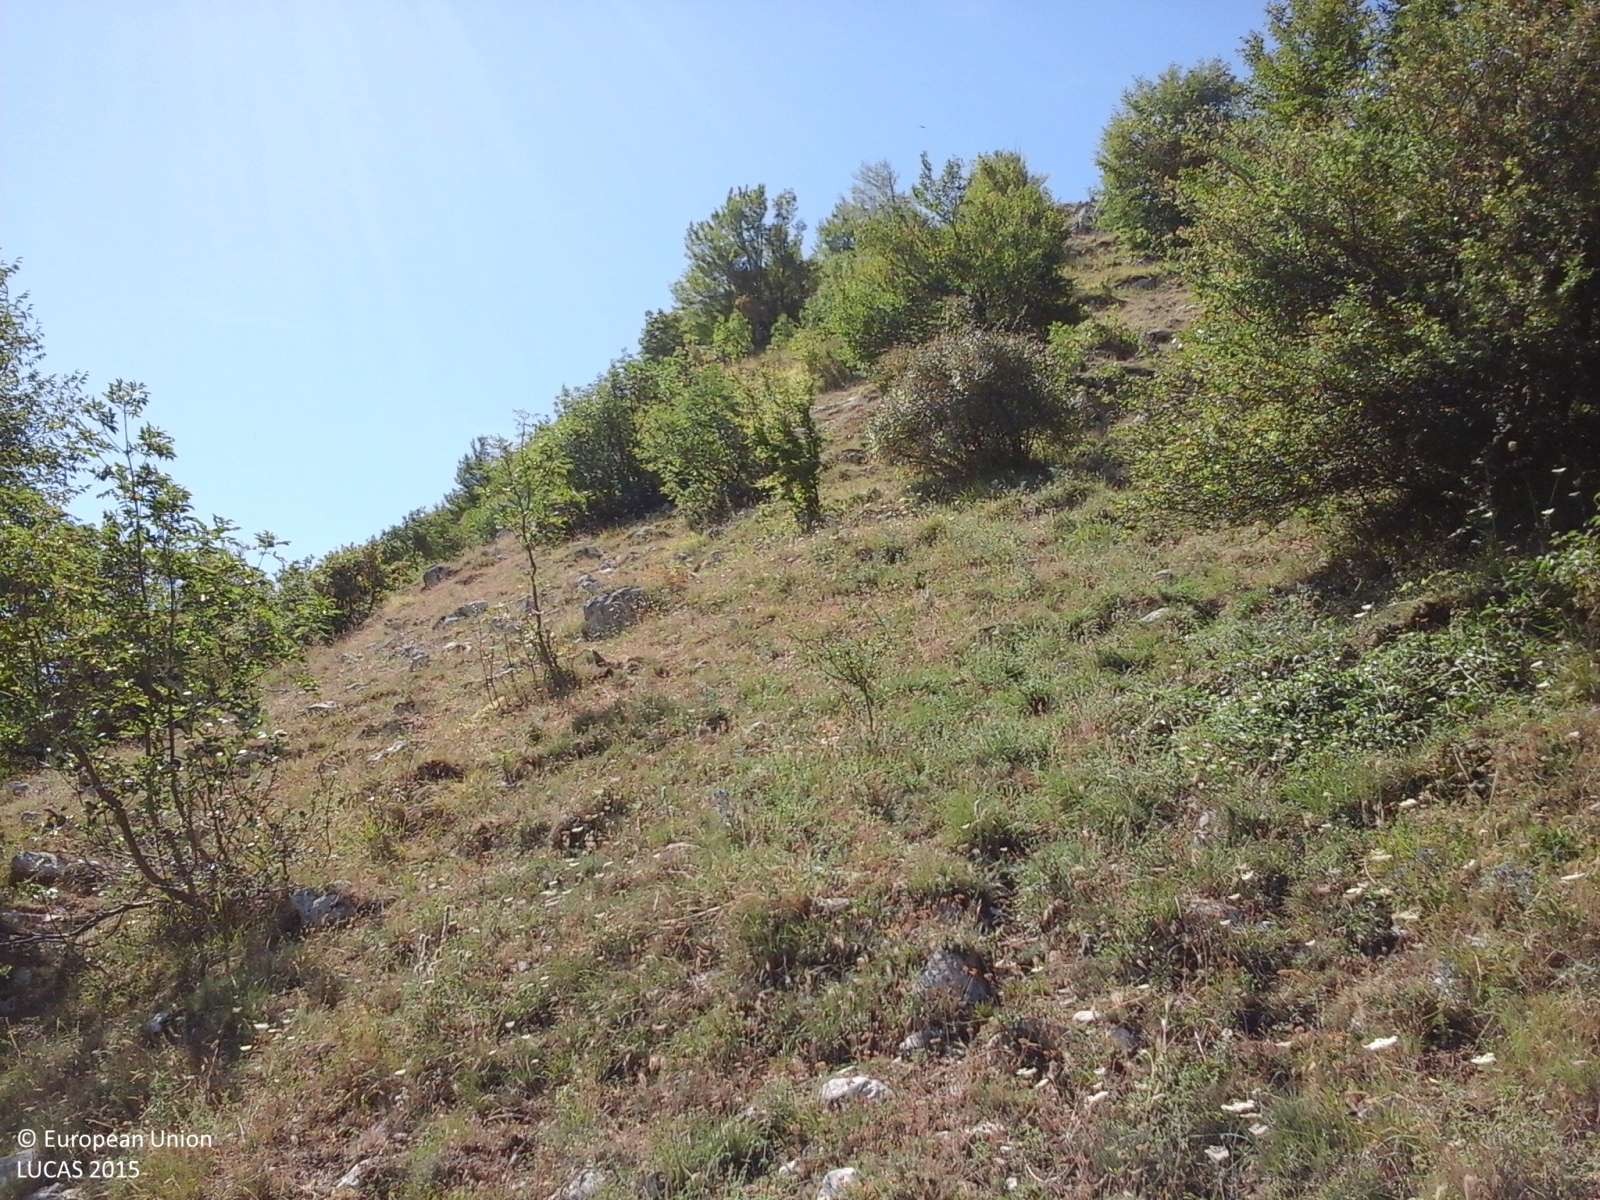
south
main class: Woodland
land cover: Broadleaved woodland
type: thermophilous deciduous forest
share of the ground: > 75 %
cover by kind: broadleaved forest trees 85 %, shrubs 10 %, herbaceous plants 5 %
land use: Semi-natural and natural areas not in use
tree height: > 5 m
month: July
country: IT
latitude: 41.4695
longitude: 14.4740
